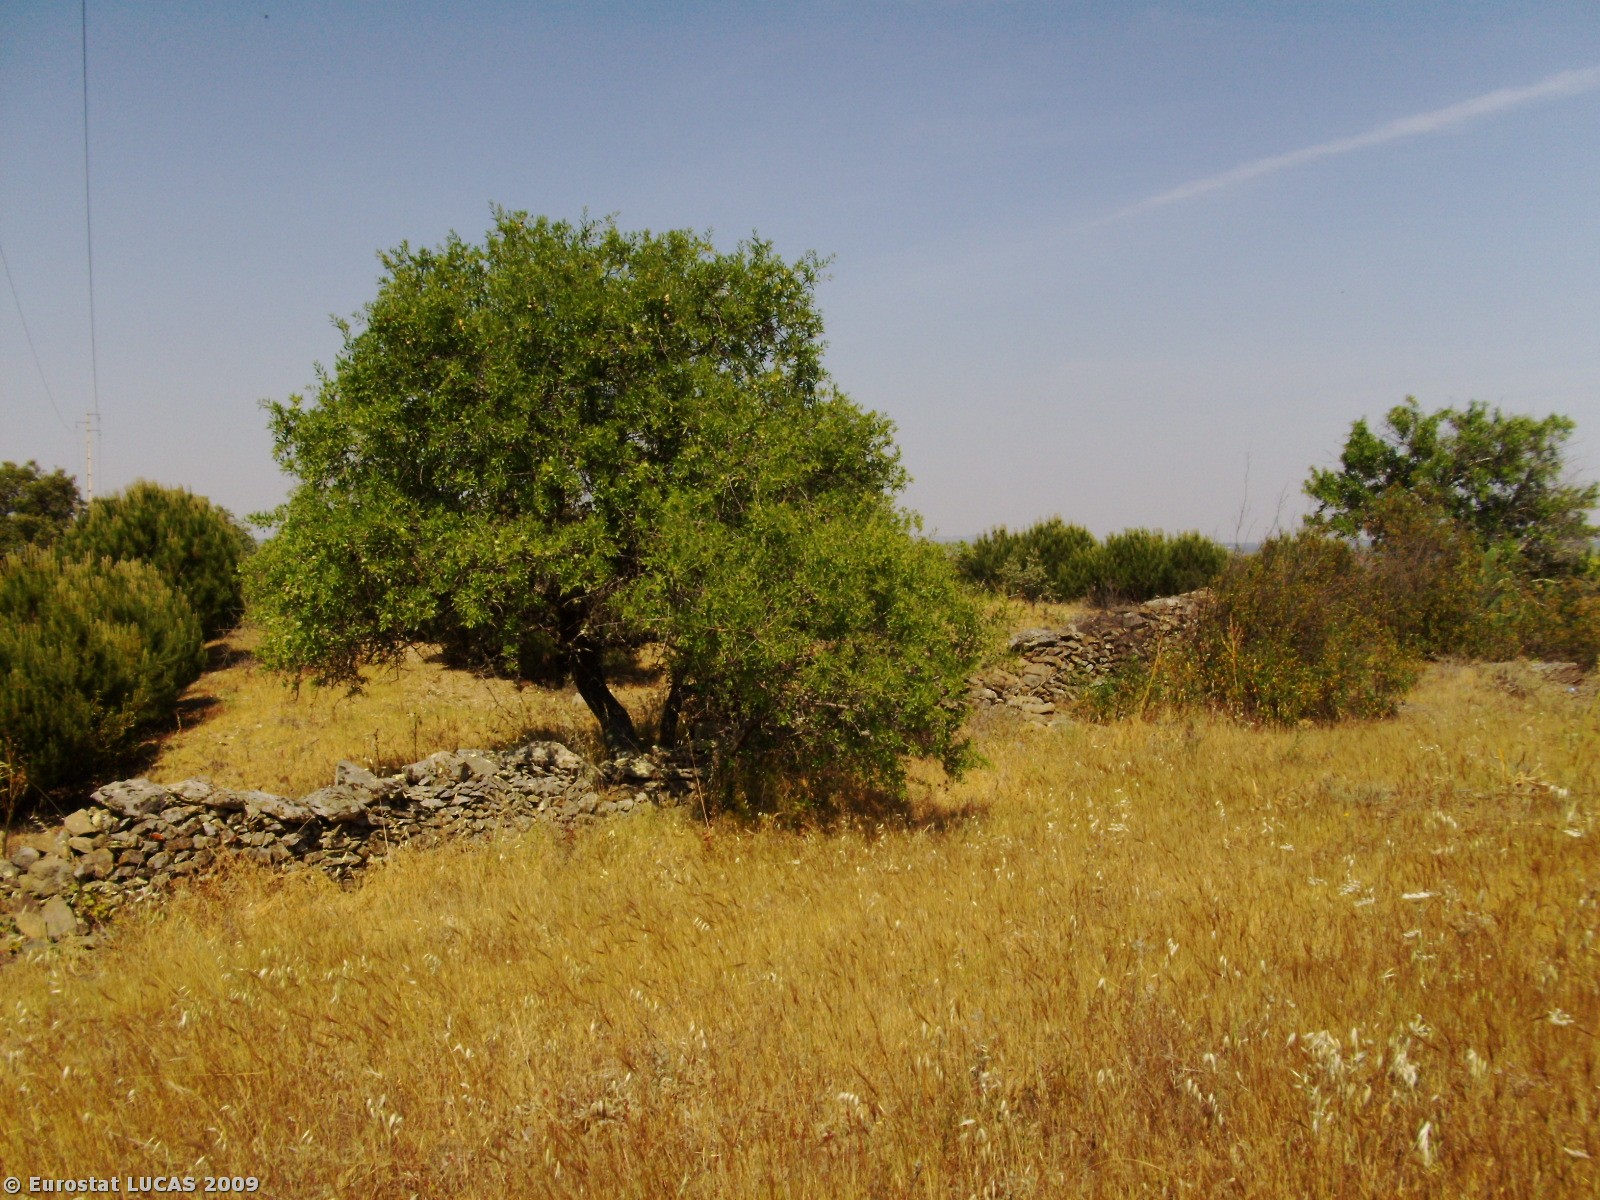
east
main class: Woodland
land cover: Coniferous woodland
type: coniferous forest of the mediterranean region
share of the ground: 10 - 25 %
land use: Forestry
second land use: Unused
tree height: > 5 m
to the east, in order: Coniferous woodland; Dry stone walls; Coniferous woodland; Dry stone walls; Shrubland with sparse tree cover
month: May
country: PT
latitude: 37.4439
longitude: -7.4938
